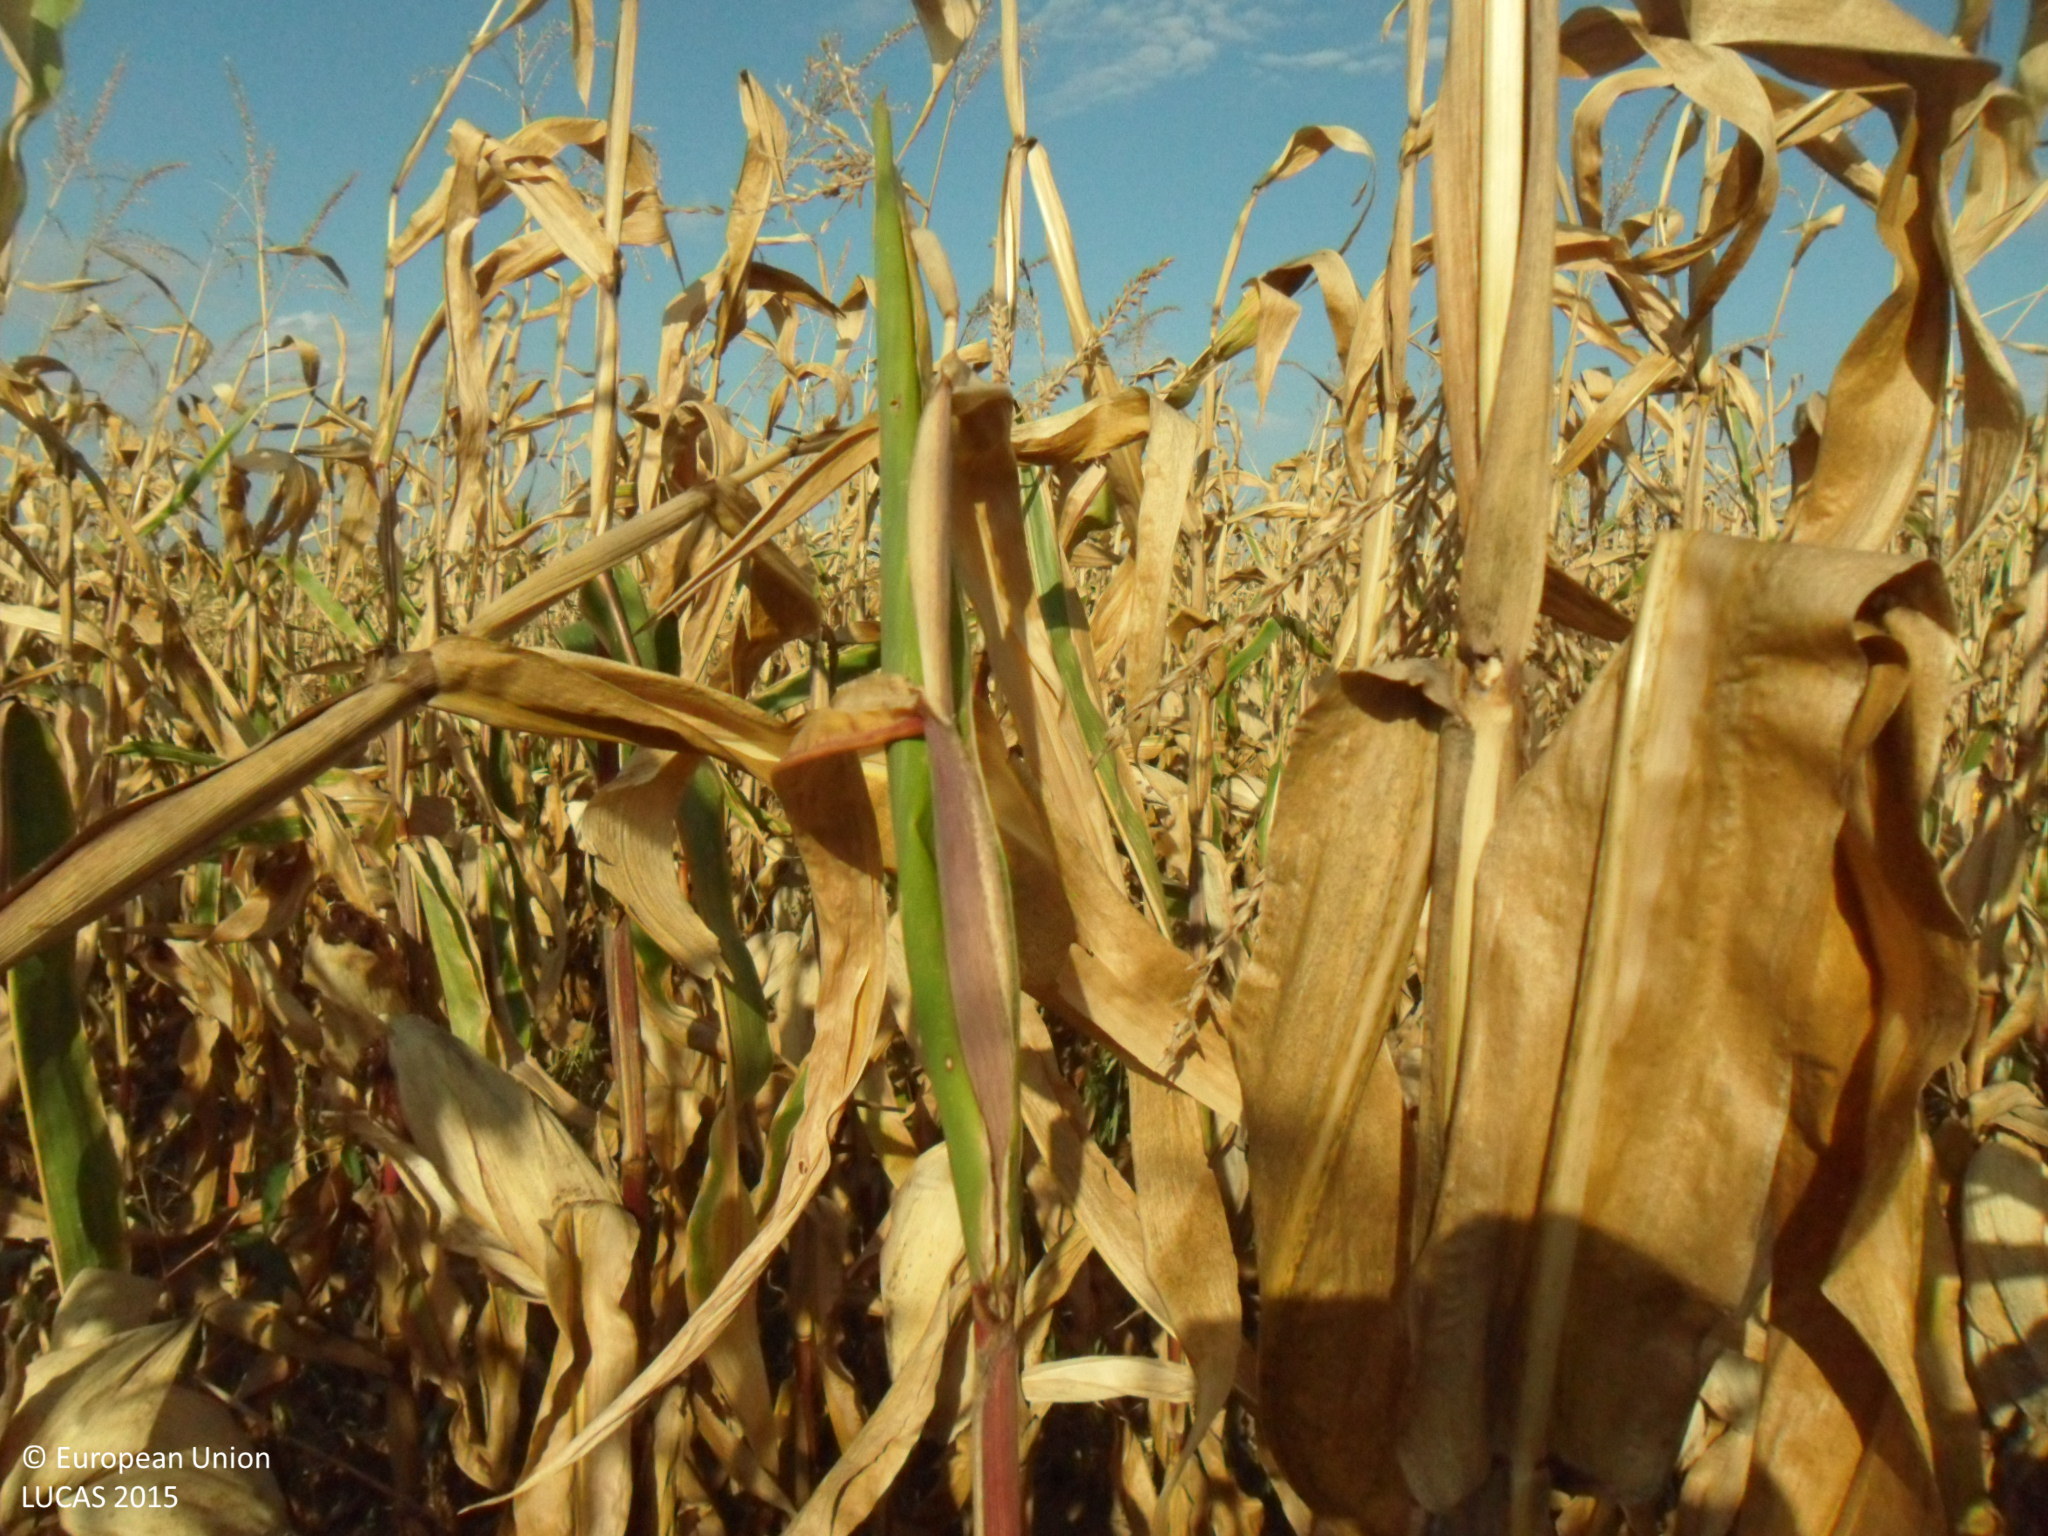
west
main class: Cropland
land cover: Maize
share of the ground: > 75 %
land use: Agriculture (excluding fallow land and kitchen gardens)
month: September
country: BG
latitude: 43.5958
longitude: 26.3413
